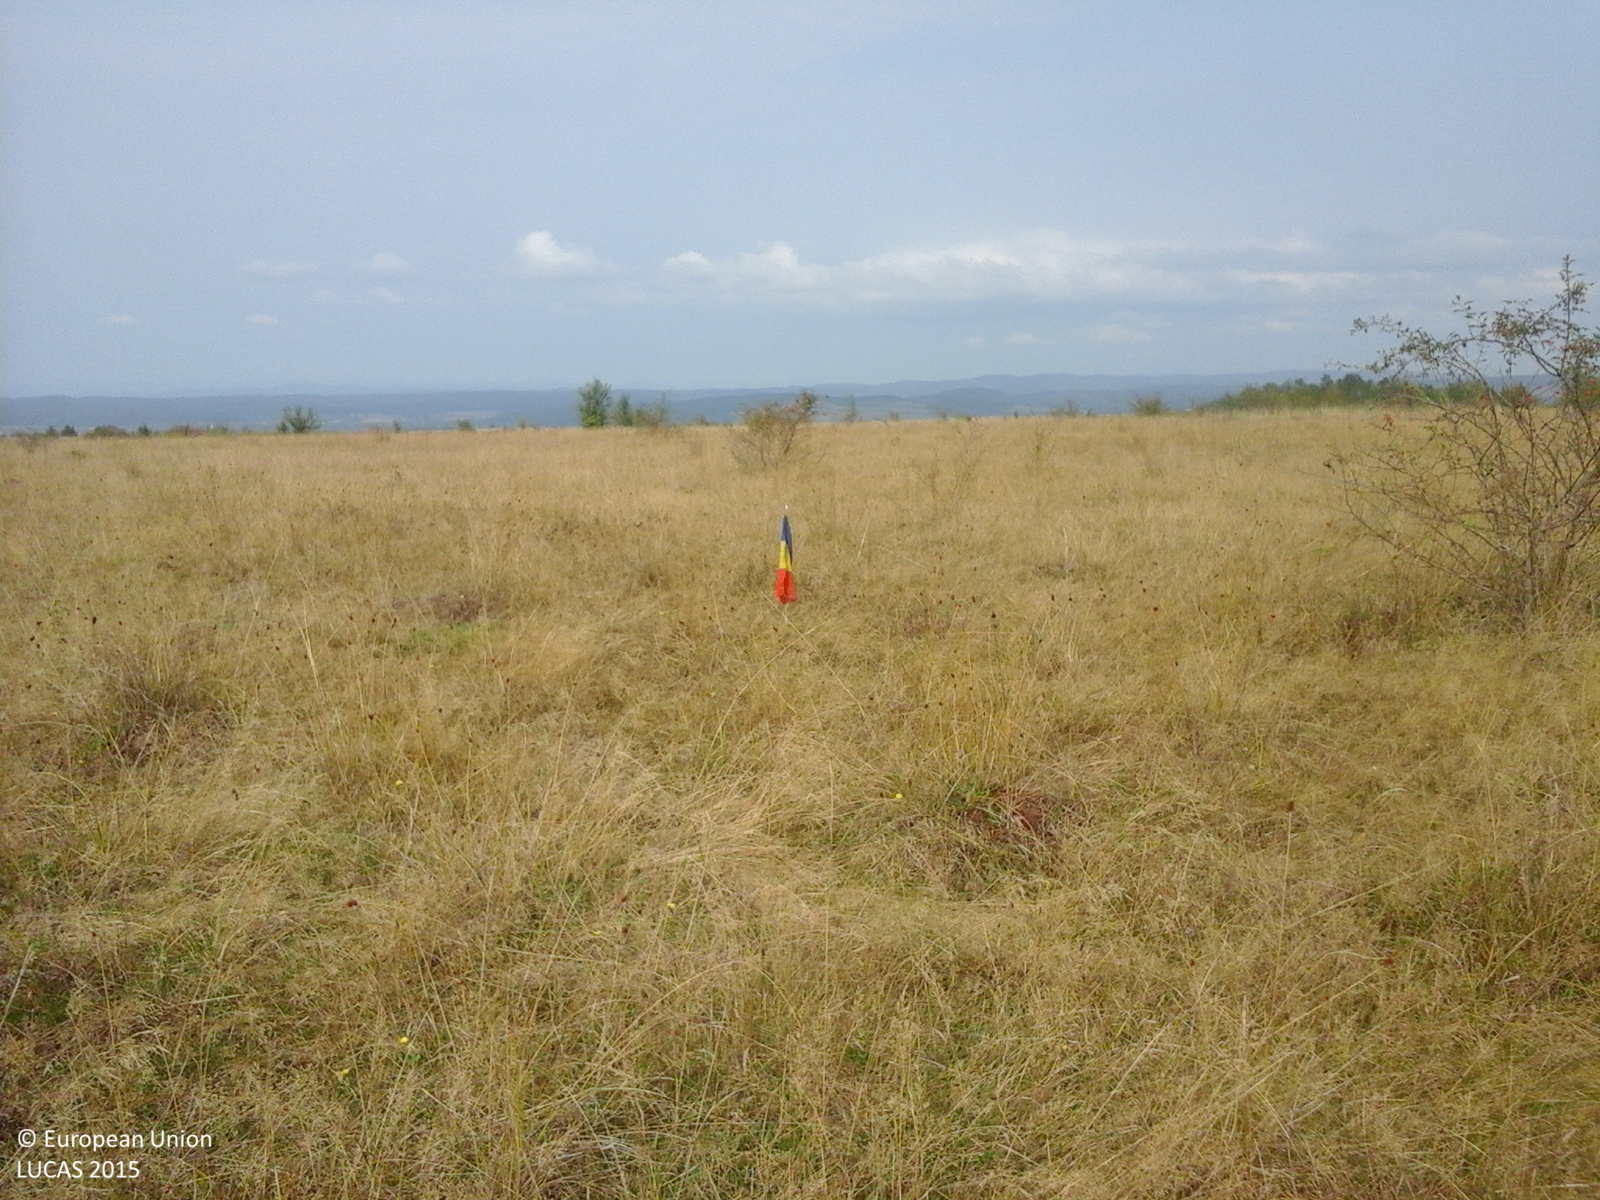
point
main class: Grassland
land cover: Grassland with sparse tree/shrub cover
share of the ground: > 75 %
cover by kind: herbaceous plants 85 %, shrubs 10 %, broadleaved forest trees 5 %
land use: Agriculture (excluding fallow land and kitchen gardens)
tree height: < 5 m
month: September
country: RO
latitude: 45.8044
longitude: 22.2809
